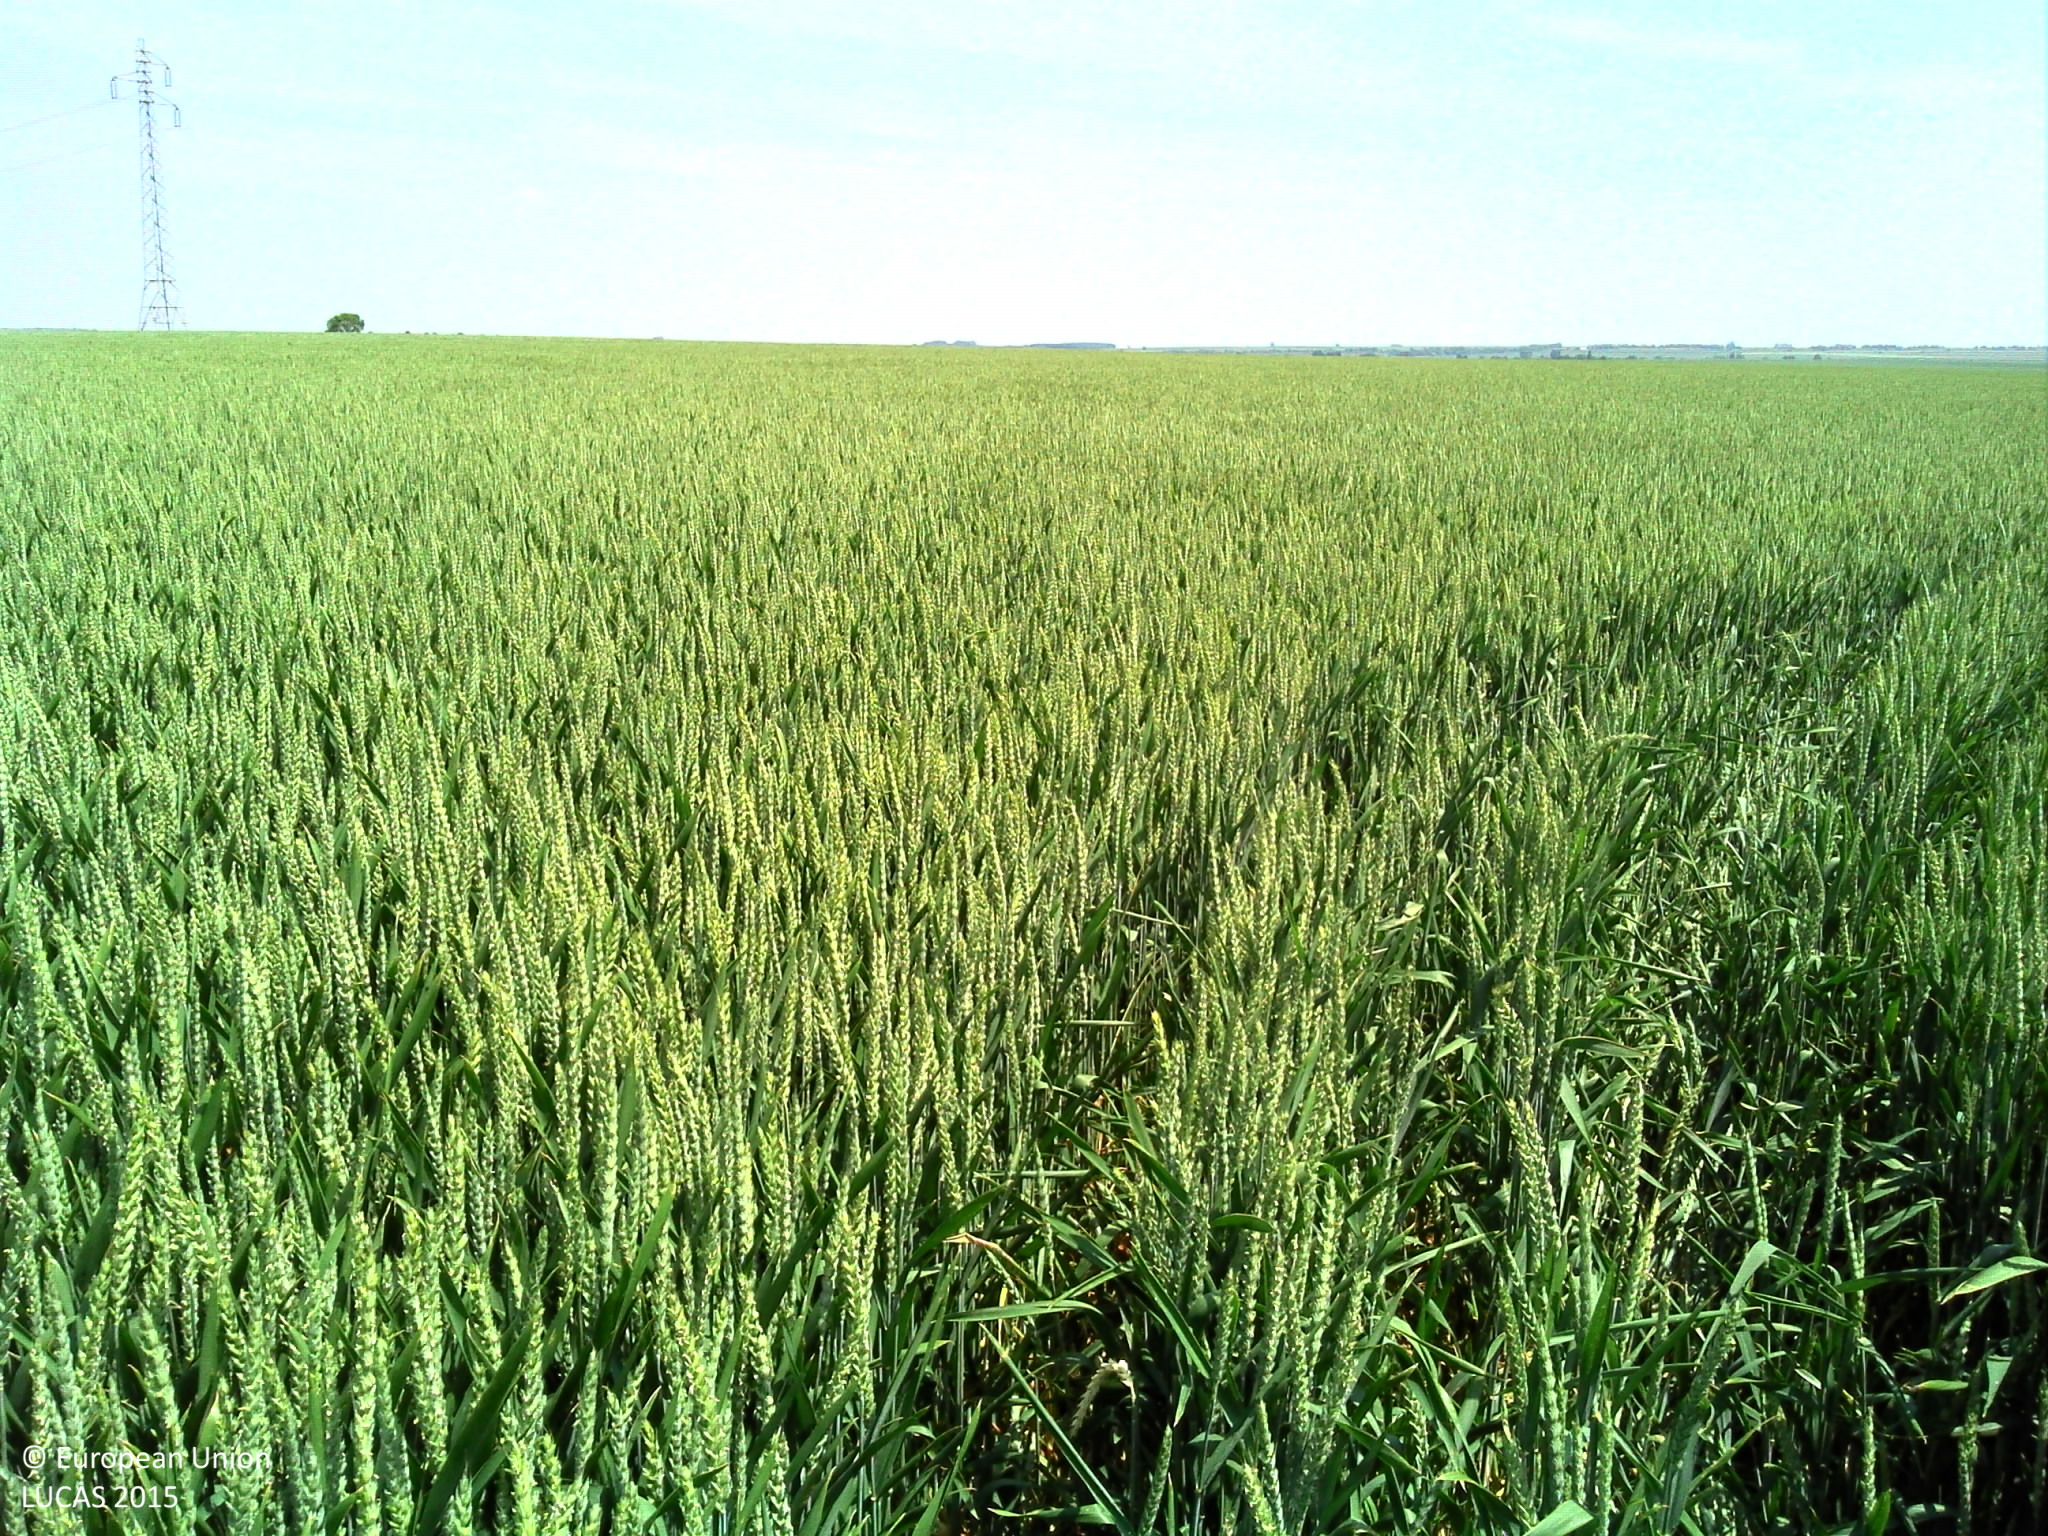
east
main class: Cropland
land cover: Common wheat
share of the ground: > 75 %
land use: Agriculture (excluding fallow land and kitchen gardens)
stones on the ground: < 10 %
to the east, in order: Common wheat; Electric lines; Common wheat
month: June
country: FR
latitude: 50.2272
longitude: 2.7981
